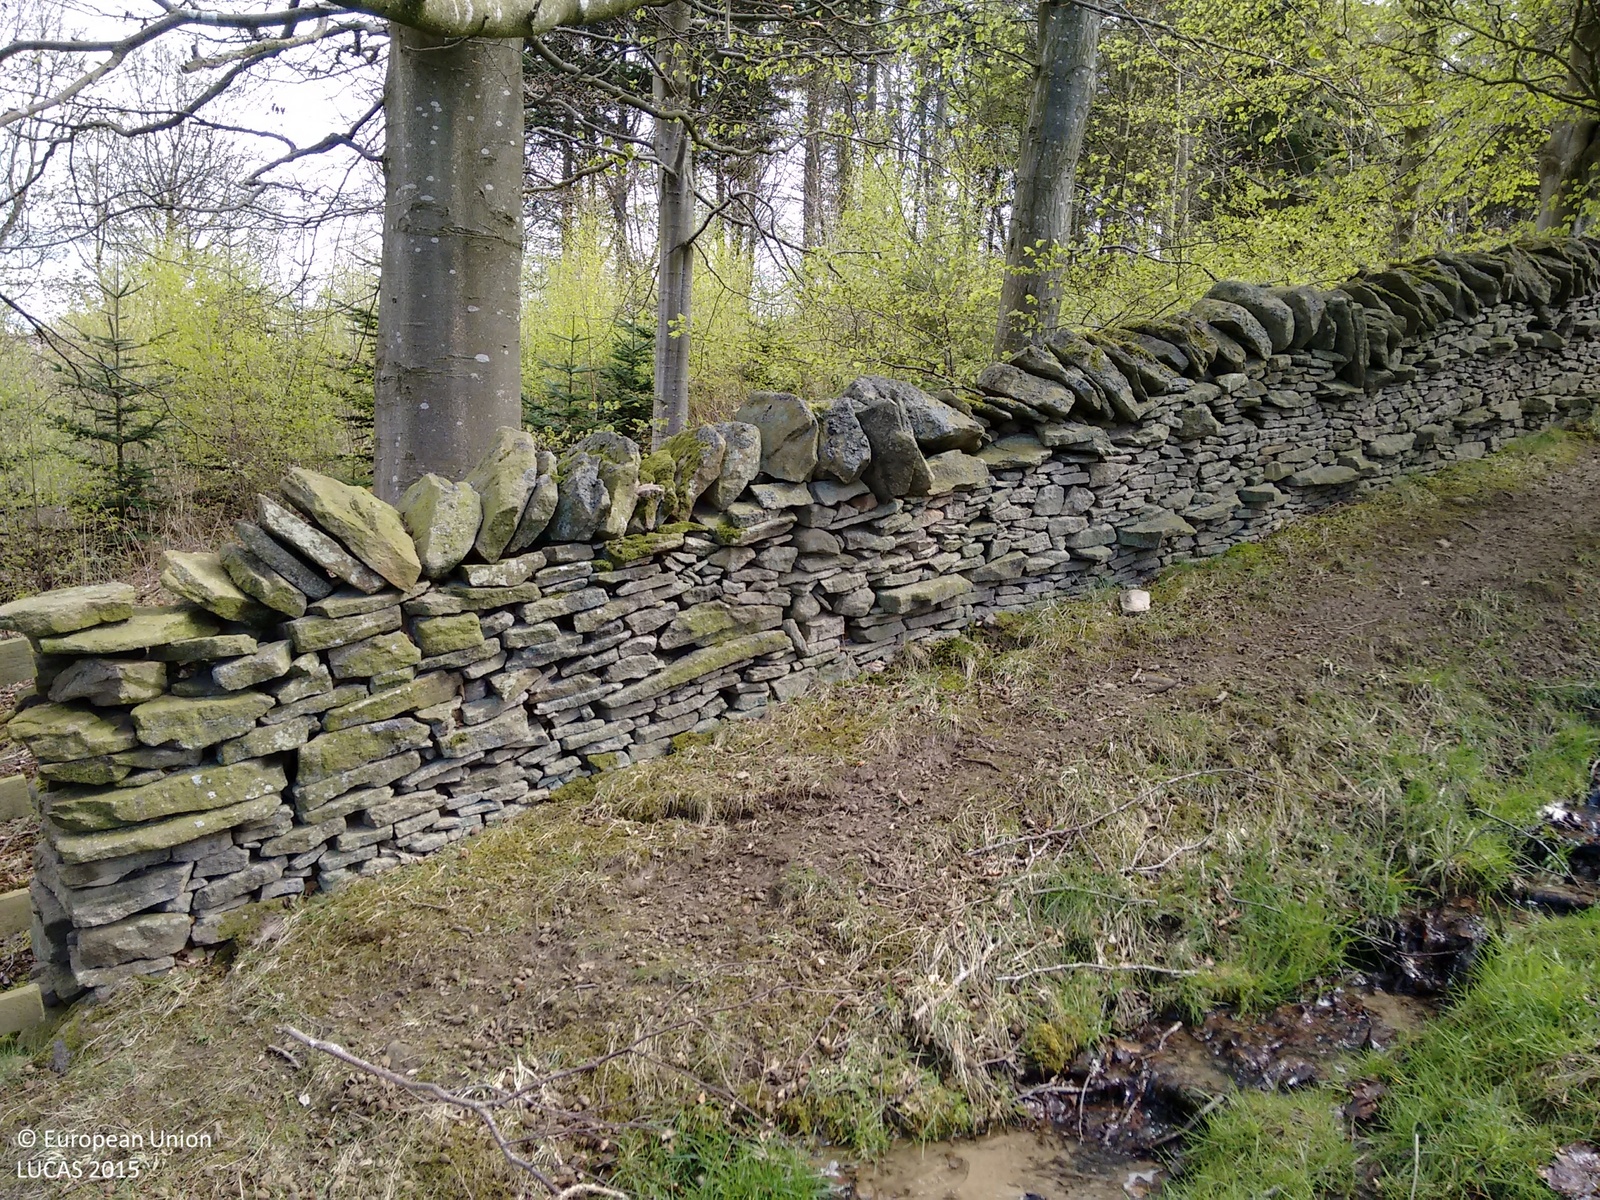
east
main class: Woodland
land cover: Broadleaved woodland
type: acidophilous oak and oak-birch forest
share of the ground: > 75 %
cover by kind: broadleaved forest trees 100 %
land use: Forestry
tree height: > 5 m
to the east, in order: Broadleaved woodland; Dry stone walls; Pine dominated coniferous woodland; Fences; Grassland without tree/shrub cover; Abandoned hedges; Grassland without tree/shrub cover; Fences; Shruby margins; Grass margins; Paved roads, cycling and walking lanes; Shruby margins; Broadleaved woodland
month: May
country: GB
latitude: 54.9577
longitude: -2.0965
